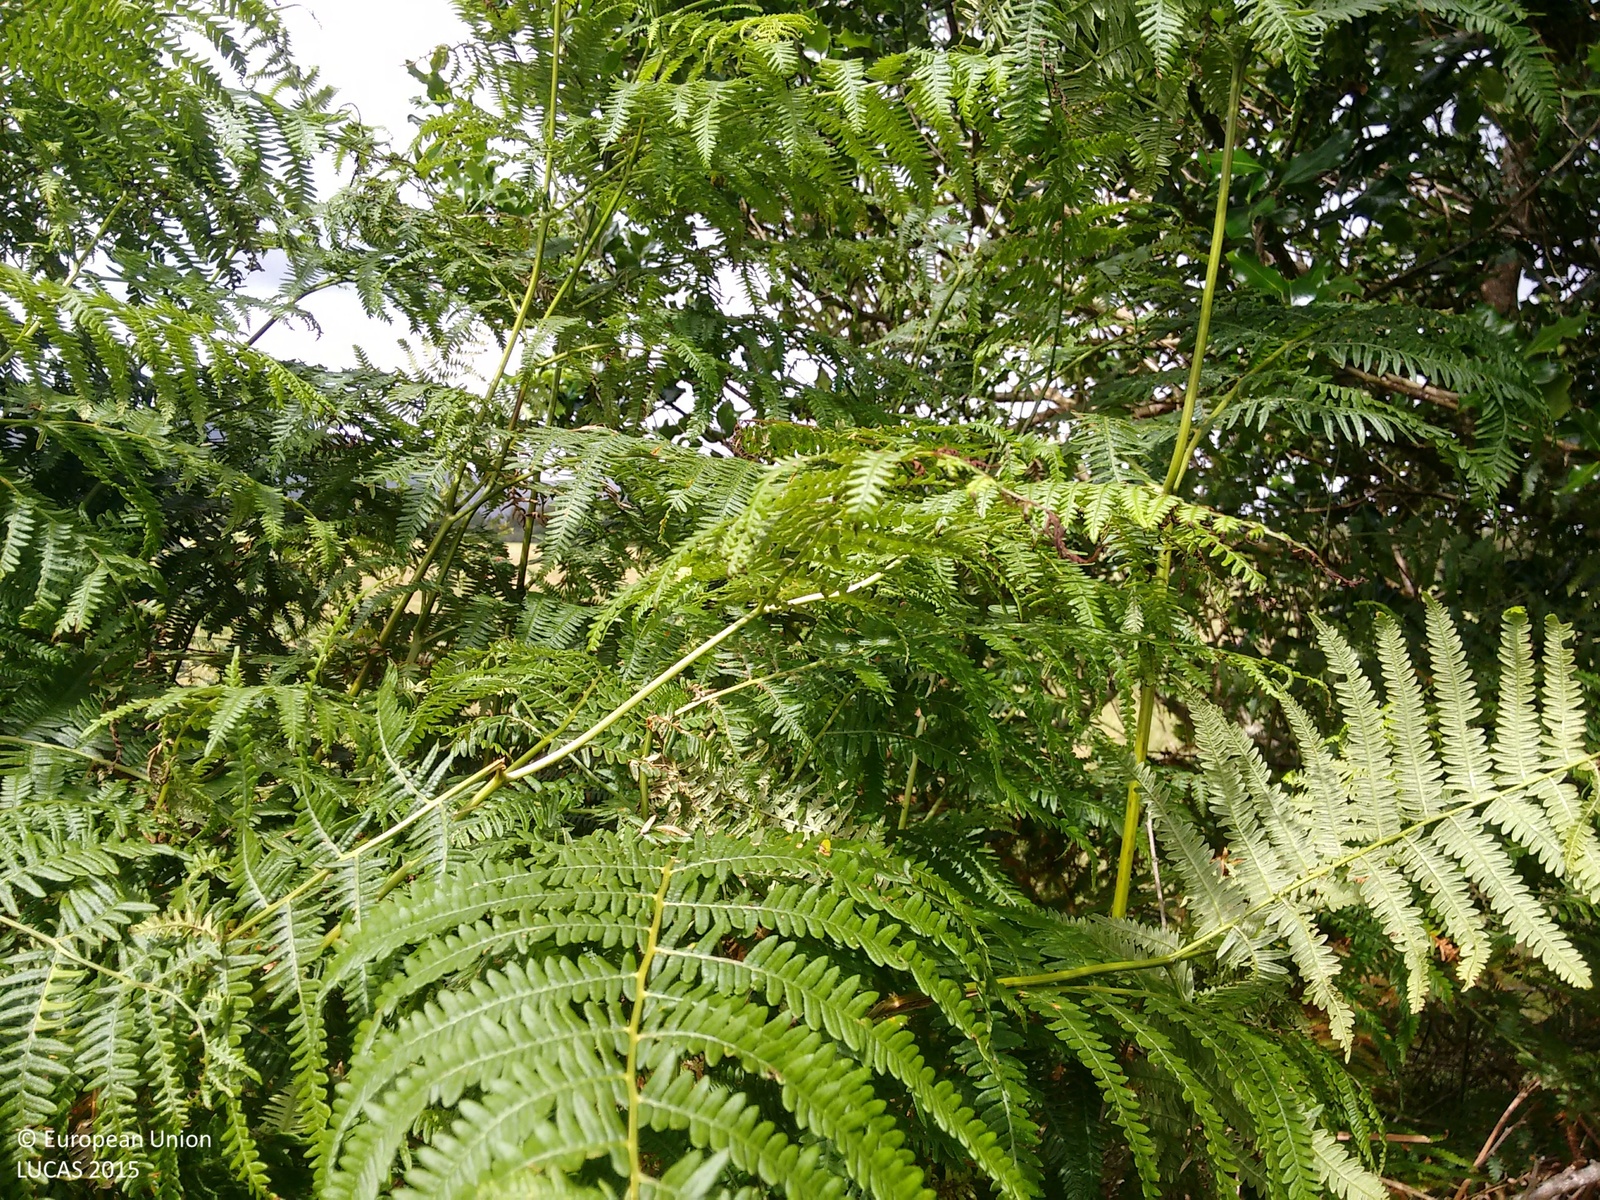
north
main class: Shrubland
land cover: Shrubland without tree cover
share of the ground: > 75 %
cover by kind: shrubs 70 %, herbaceous plants 30 %
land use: Agriculture (excluding fallow land and kitchen gardens)
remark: Harvested field
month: August
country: IE
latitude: 51.7281
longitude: -9.4429
